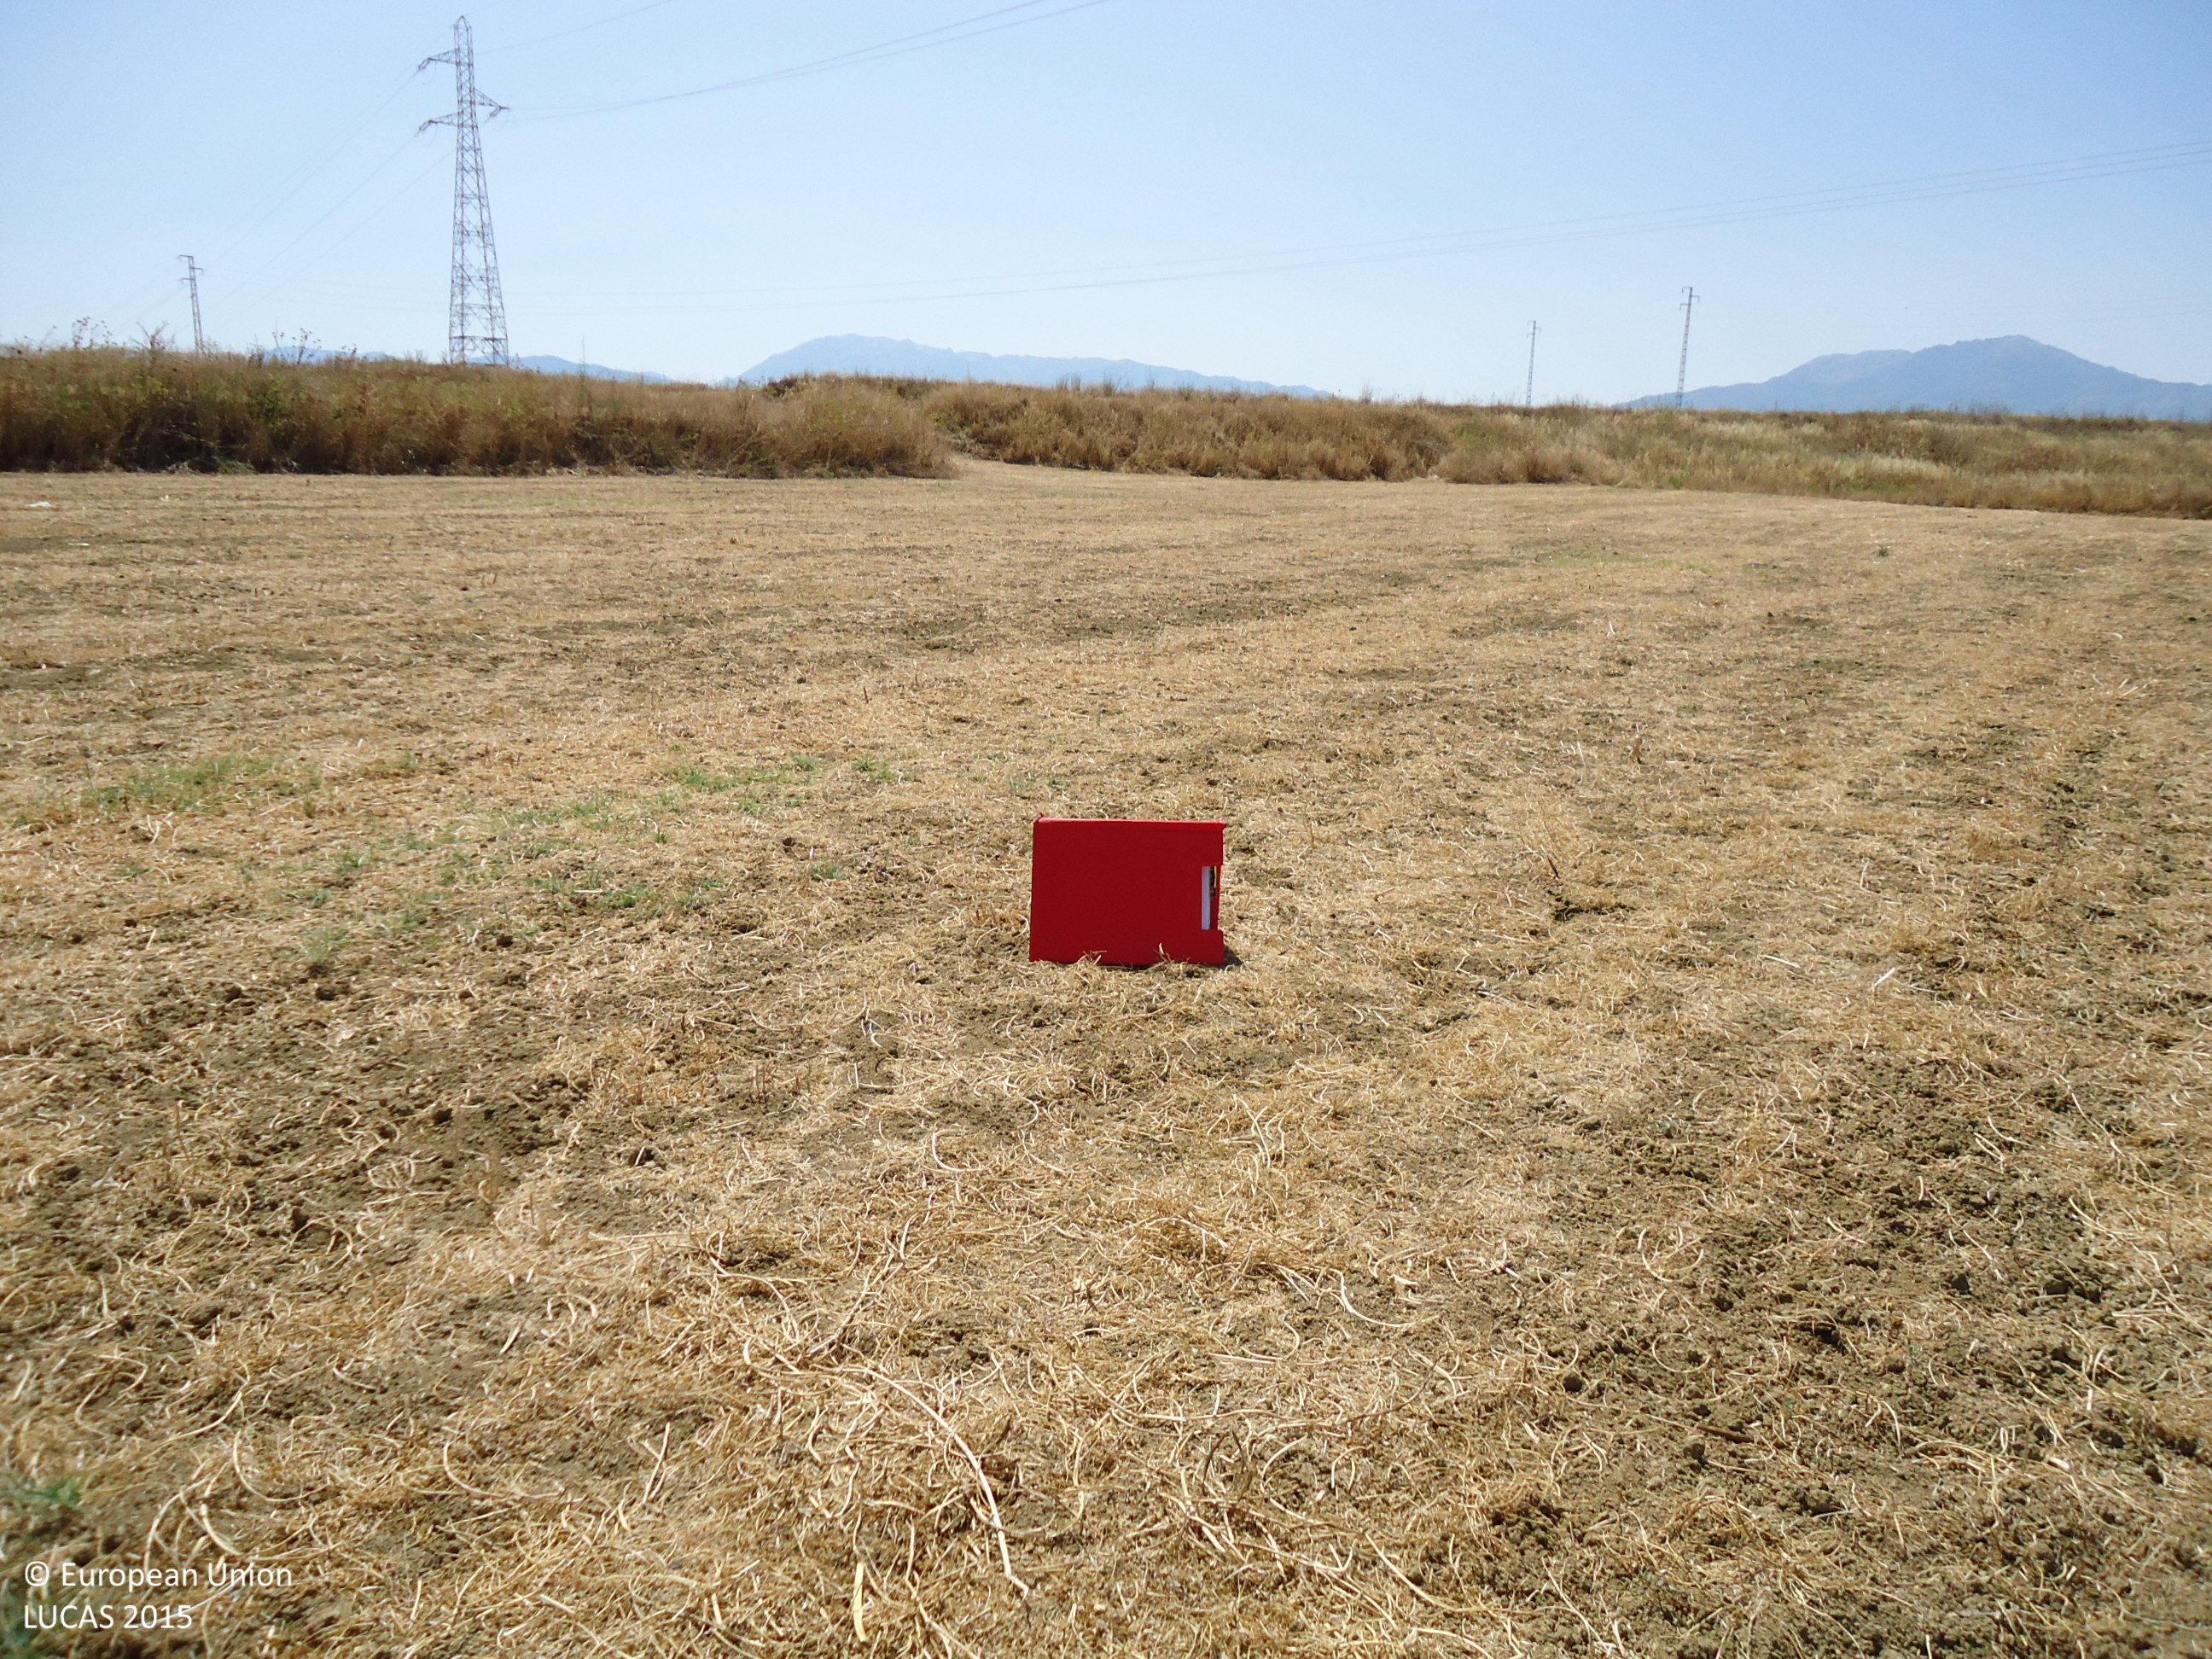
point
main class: Grassland
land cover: Spontaneously vegetated surfaces
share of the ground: > 75 %
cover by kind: herbaceous plants 90 %, unconsolidated bare surface 10 %
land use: Agriculture (excluding fallow land and kitchen gardens)
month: June
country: ES
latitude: 36.6854
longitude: -4.7314
